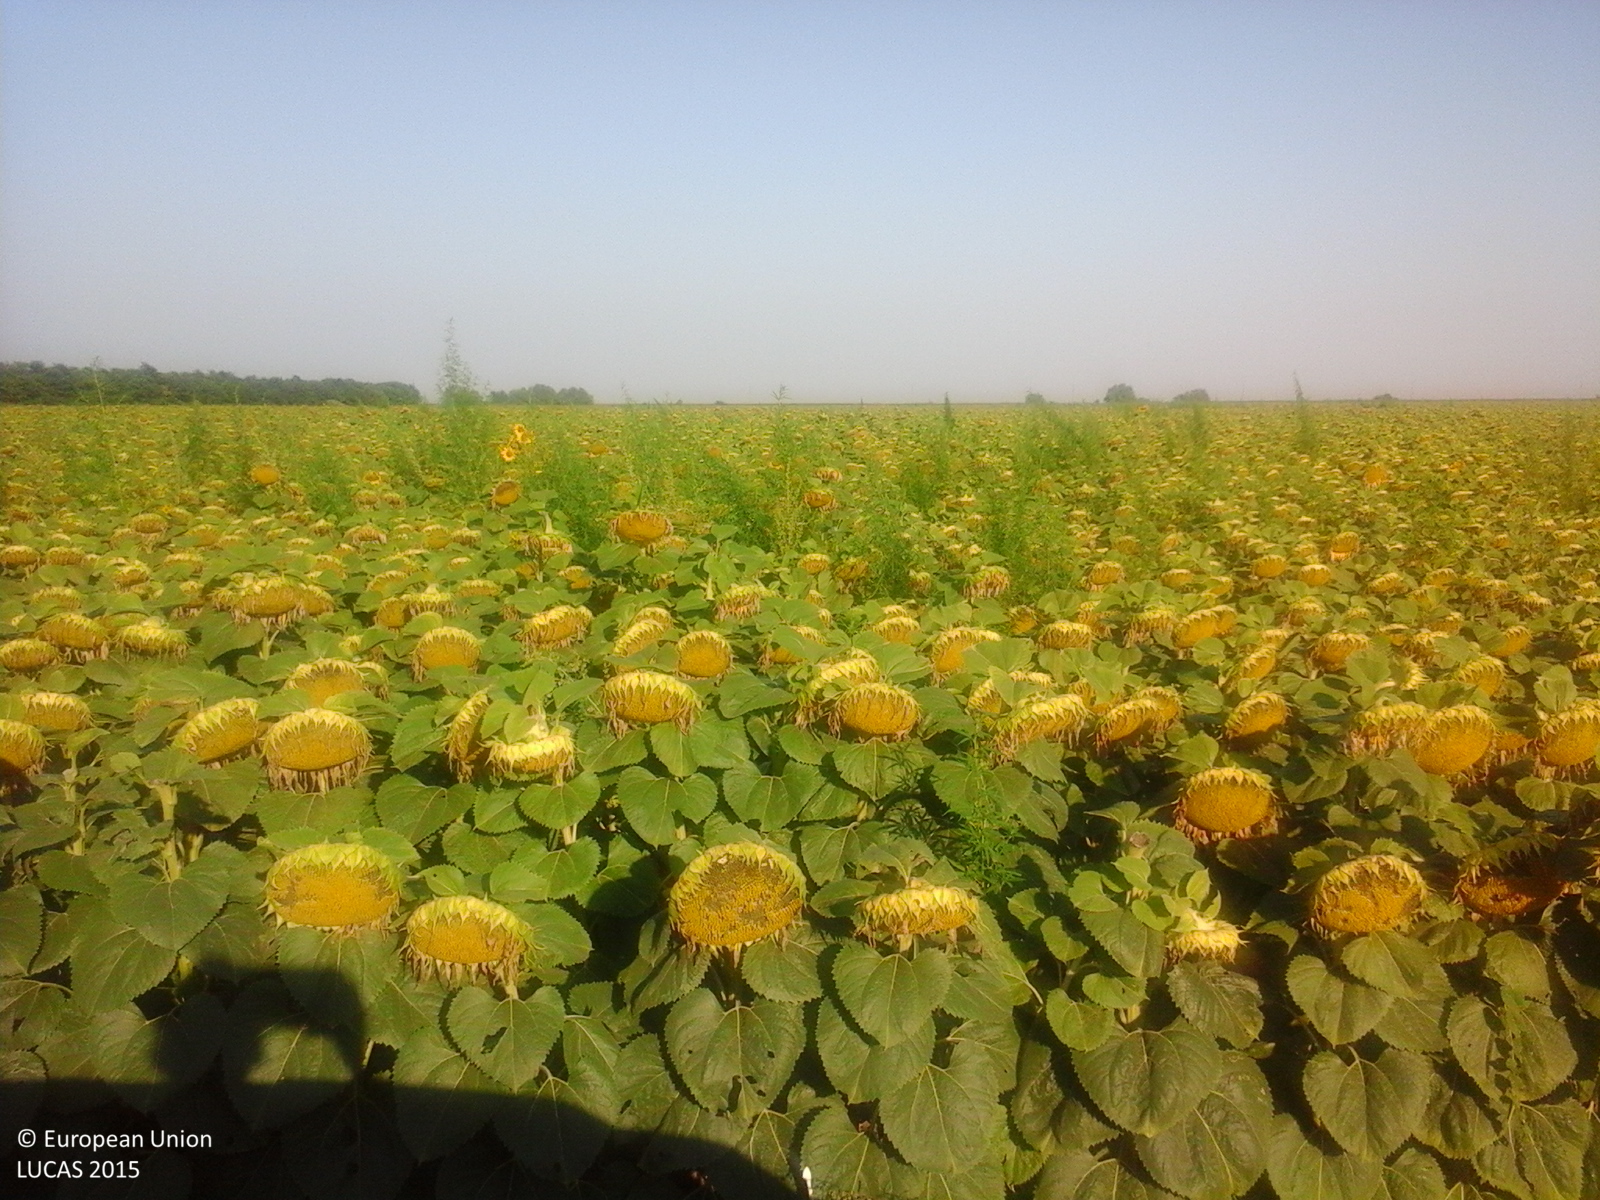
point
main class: Cropland
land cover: Sunflower
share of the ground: > 75 %
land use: Agriculture (excluding fallow land and kitchen gardens)
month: July
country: RO
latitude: 44.4982
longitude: 27.2267
